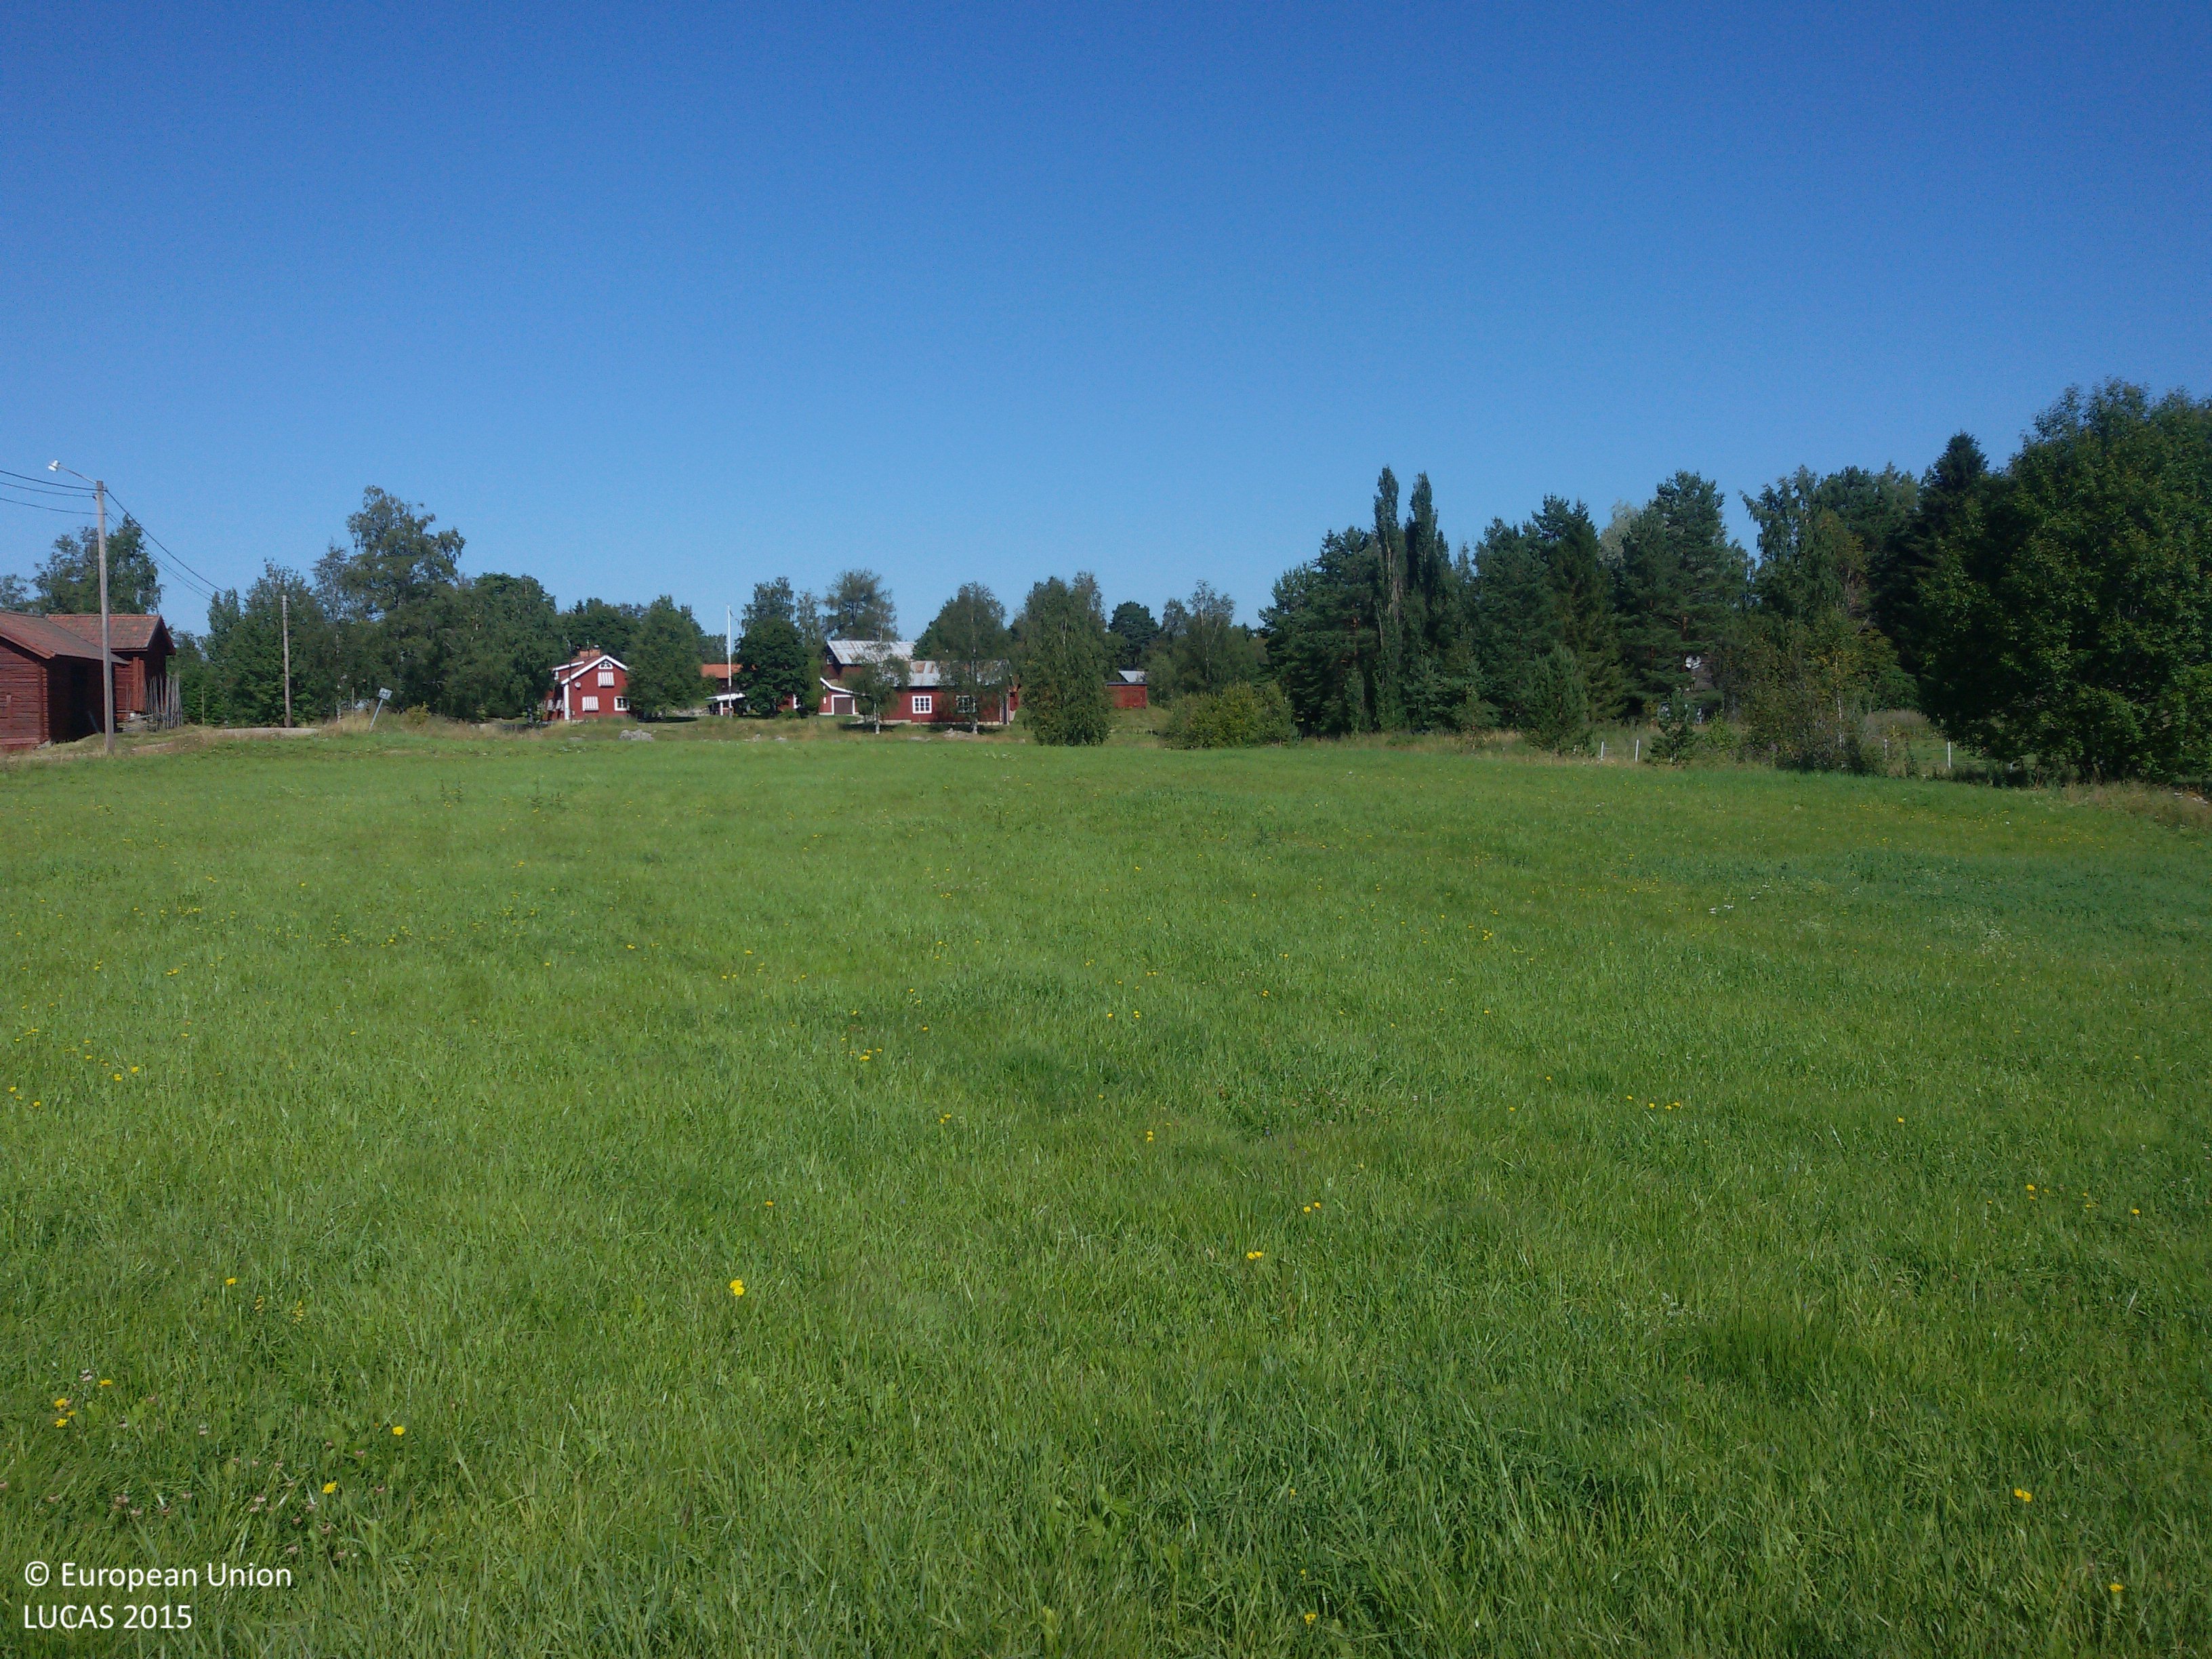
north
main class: Grassland
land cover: Grassland without tree/shrub cover
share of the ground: > 75 %
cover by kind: herbaceous plants 100 %
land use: Agriculture (excluding fallow land and kitchen gardens)
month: August
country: SE
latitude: 60.6370
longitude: 15.8561
